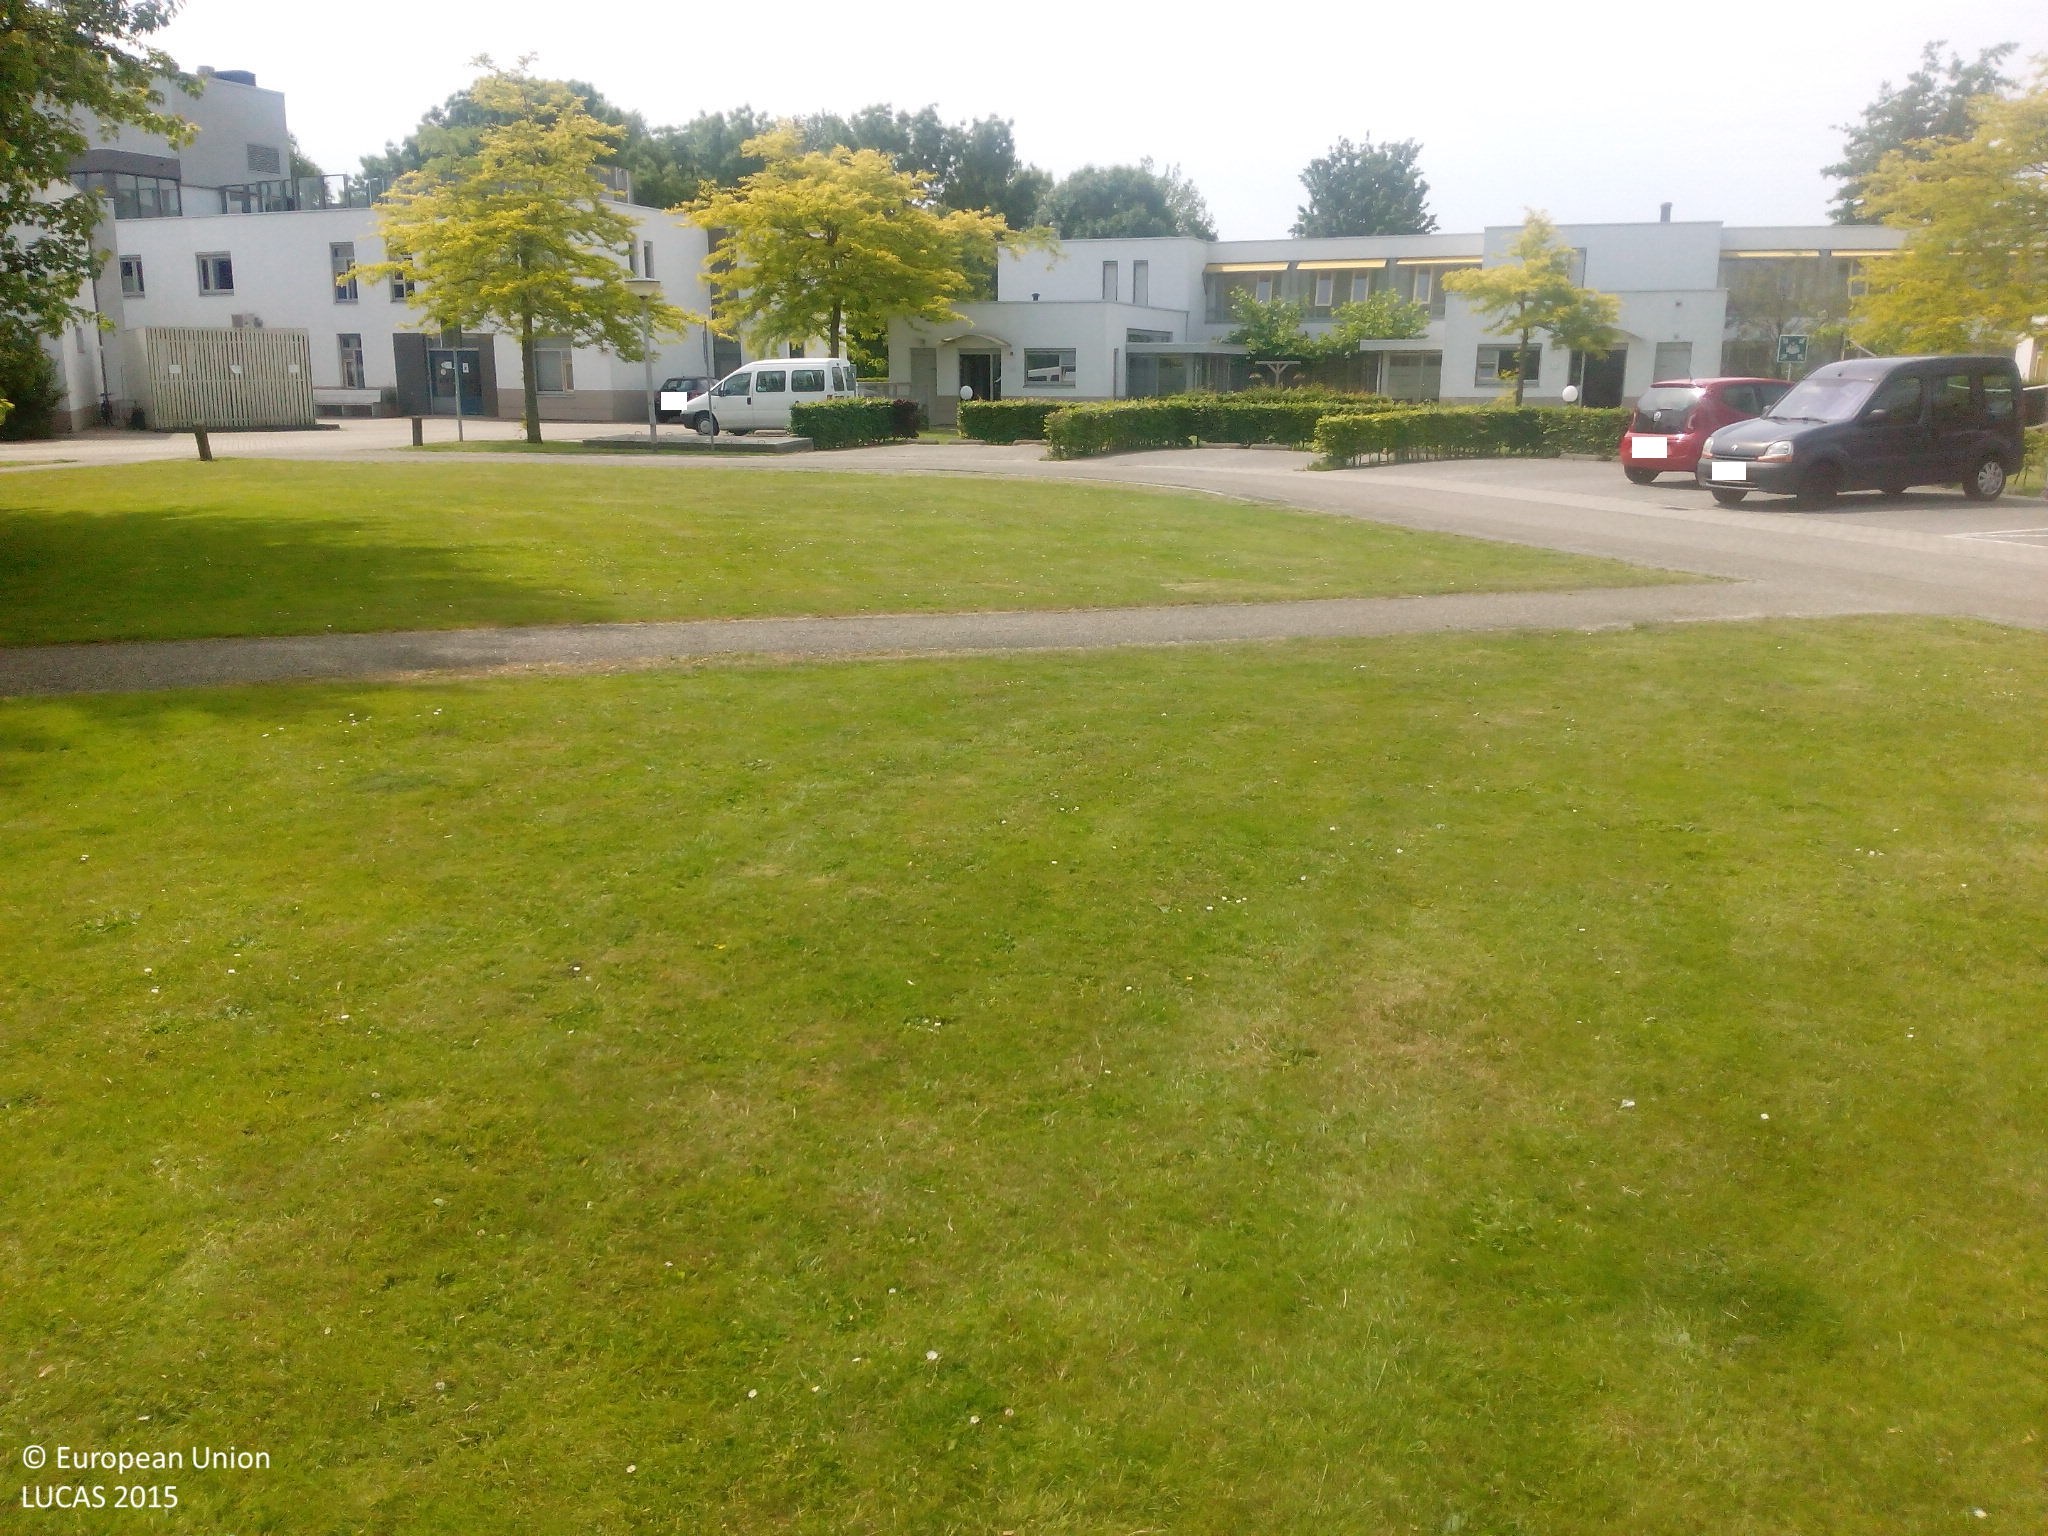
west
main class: Woodland
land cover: Broadleaved woodland
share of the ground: 25 - 50 %
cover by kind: herbaceous plants 55 %, broadleaved forest trees 30 %, consolidated bare surface 15 %
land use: Residential
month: June
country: NL
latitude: 51.8366
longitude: 4.1460
